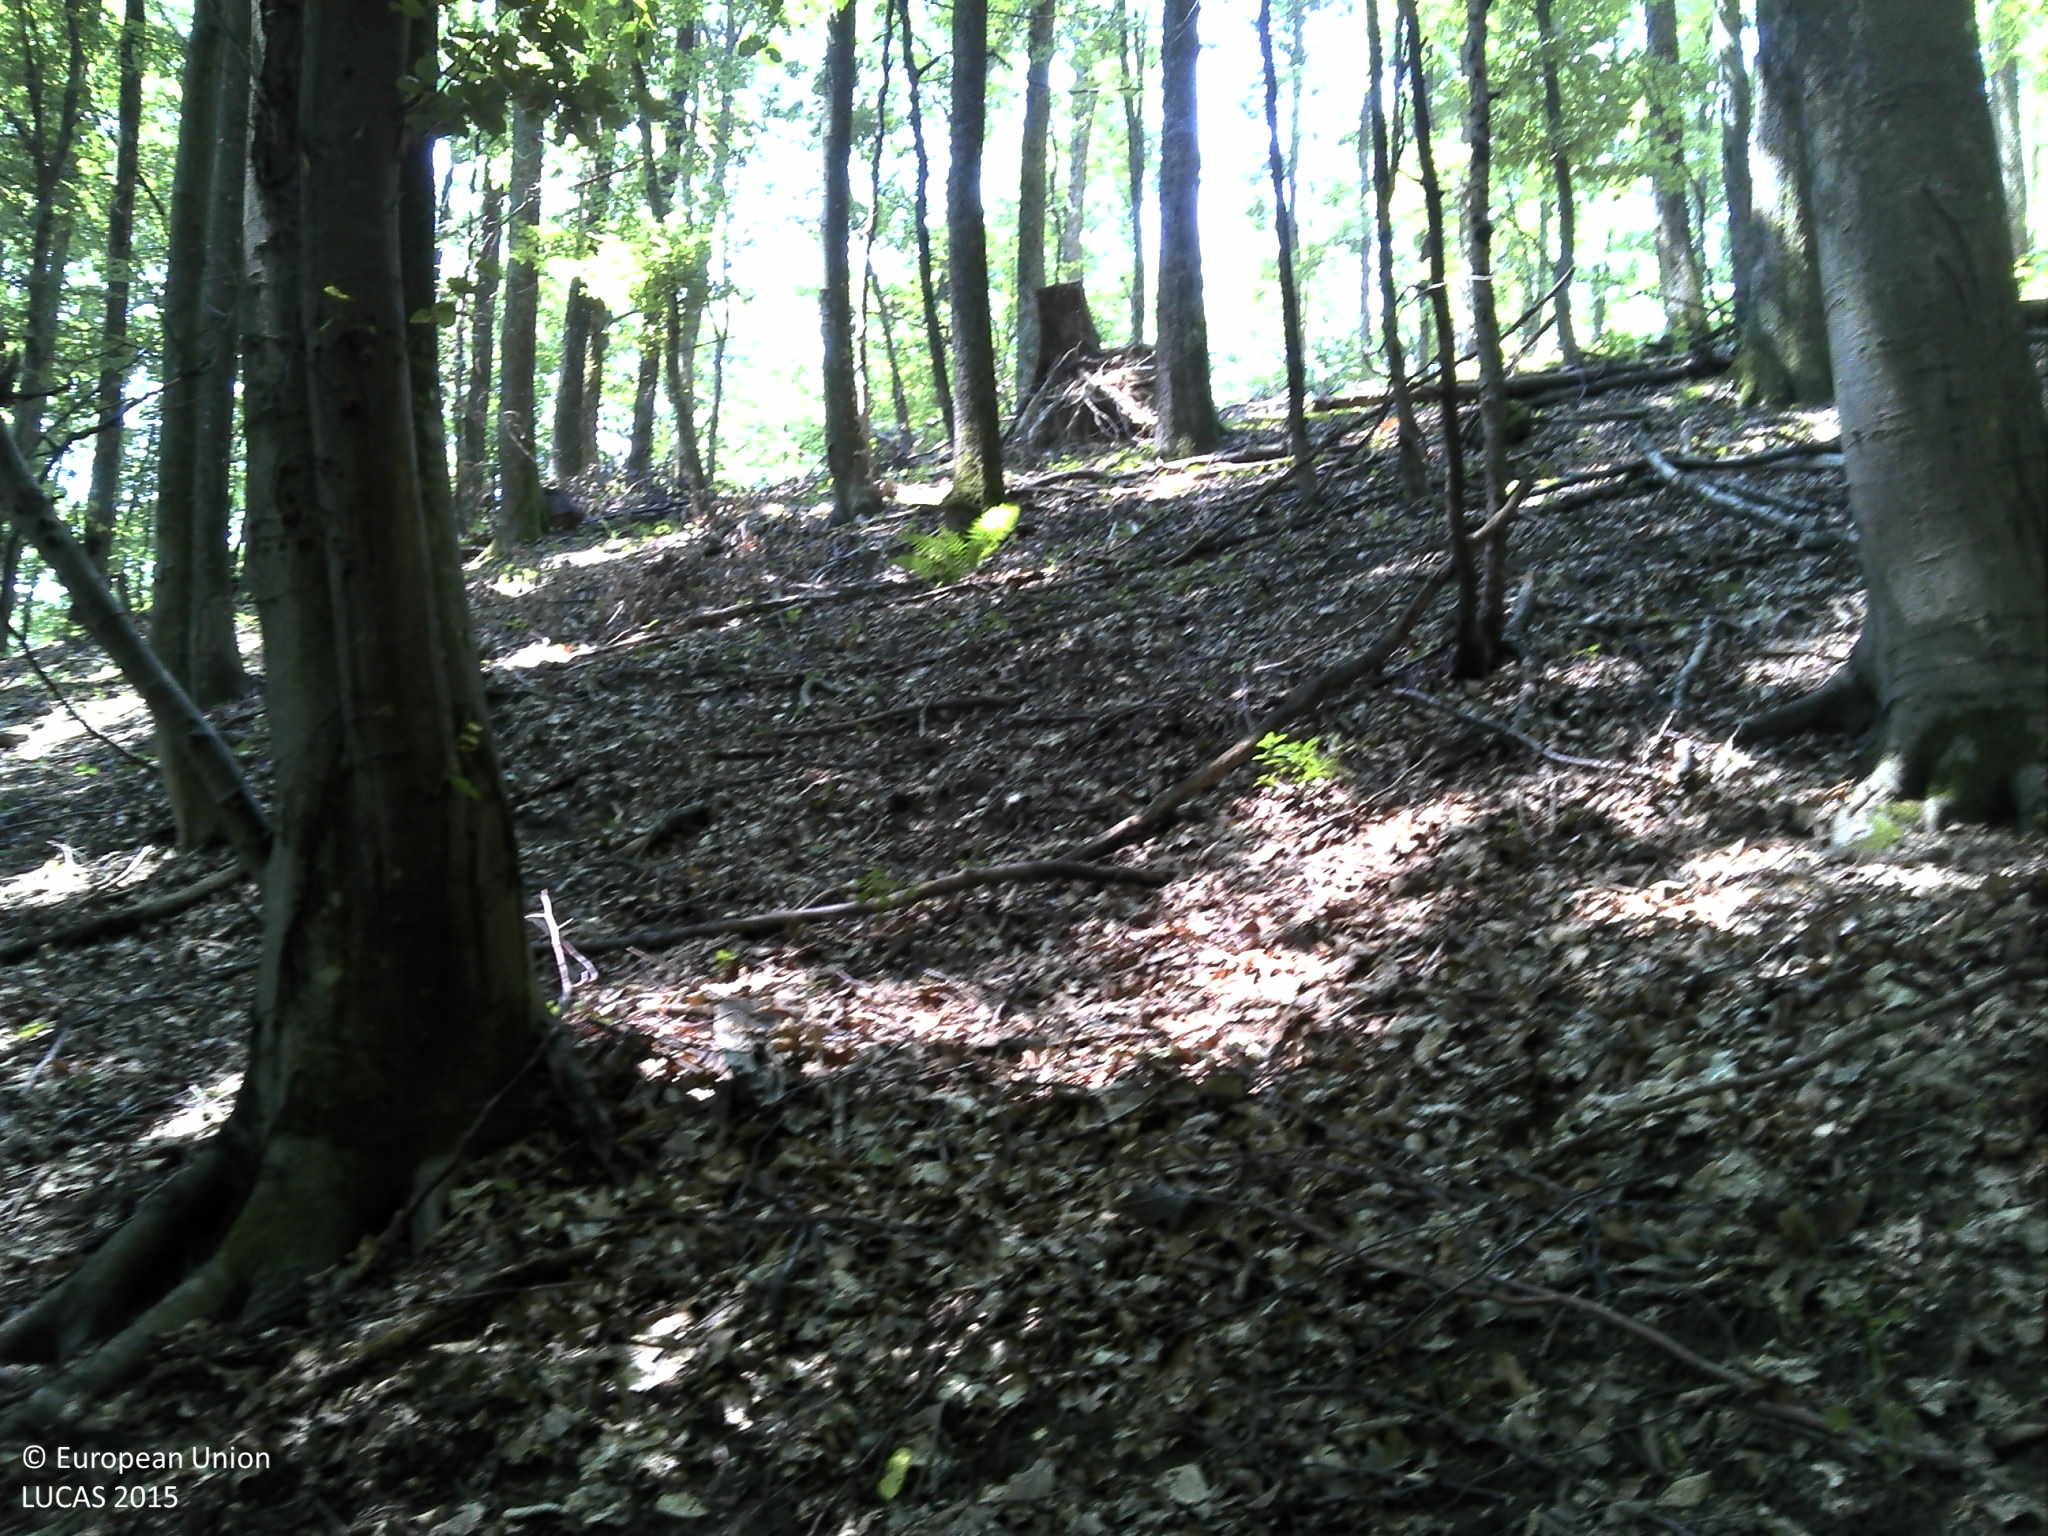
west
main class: Woodland
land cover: Broadleaved woodland
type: beech forest
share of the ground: > 75 %
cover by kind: broadleaved forest trees 80 %, lichens and mosses 20 %
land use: Forestry
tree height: > 5 m
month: July
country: HR
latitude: 45.6149
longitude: 16.7317
